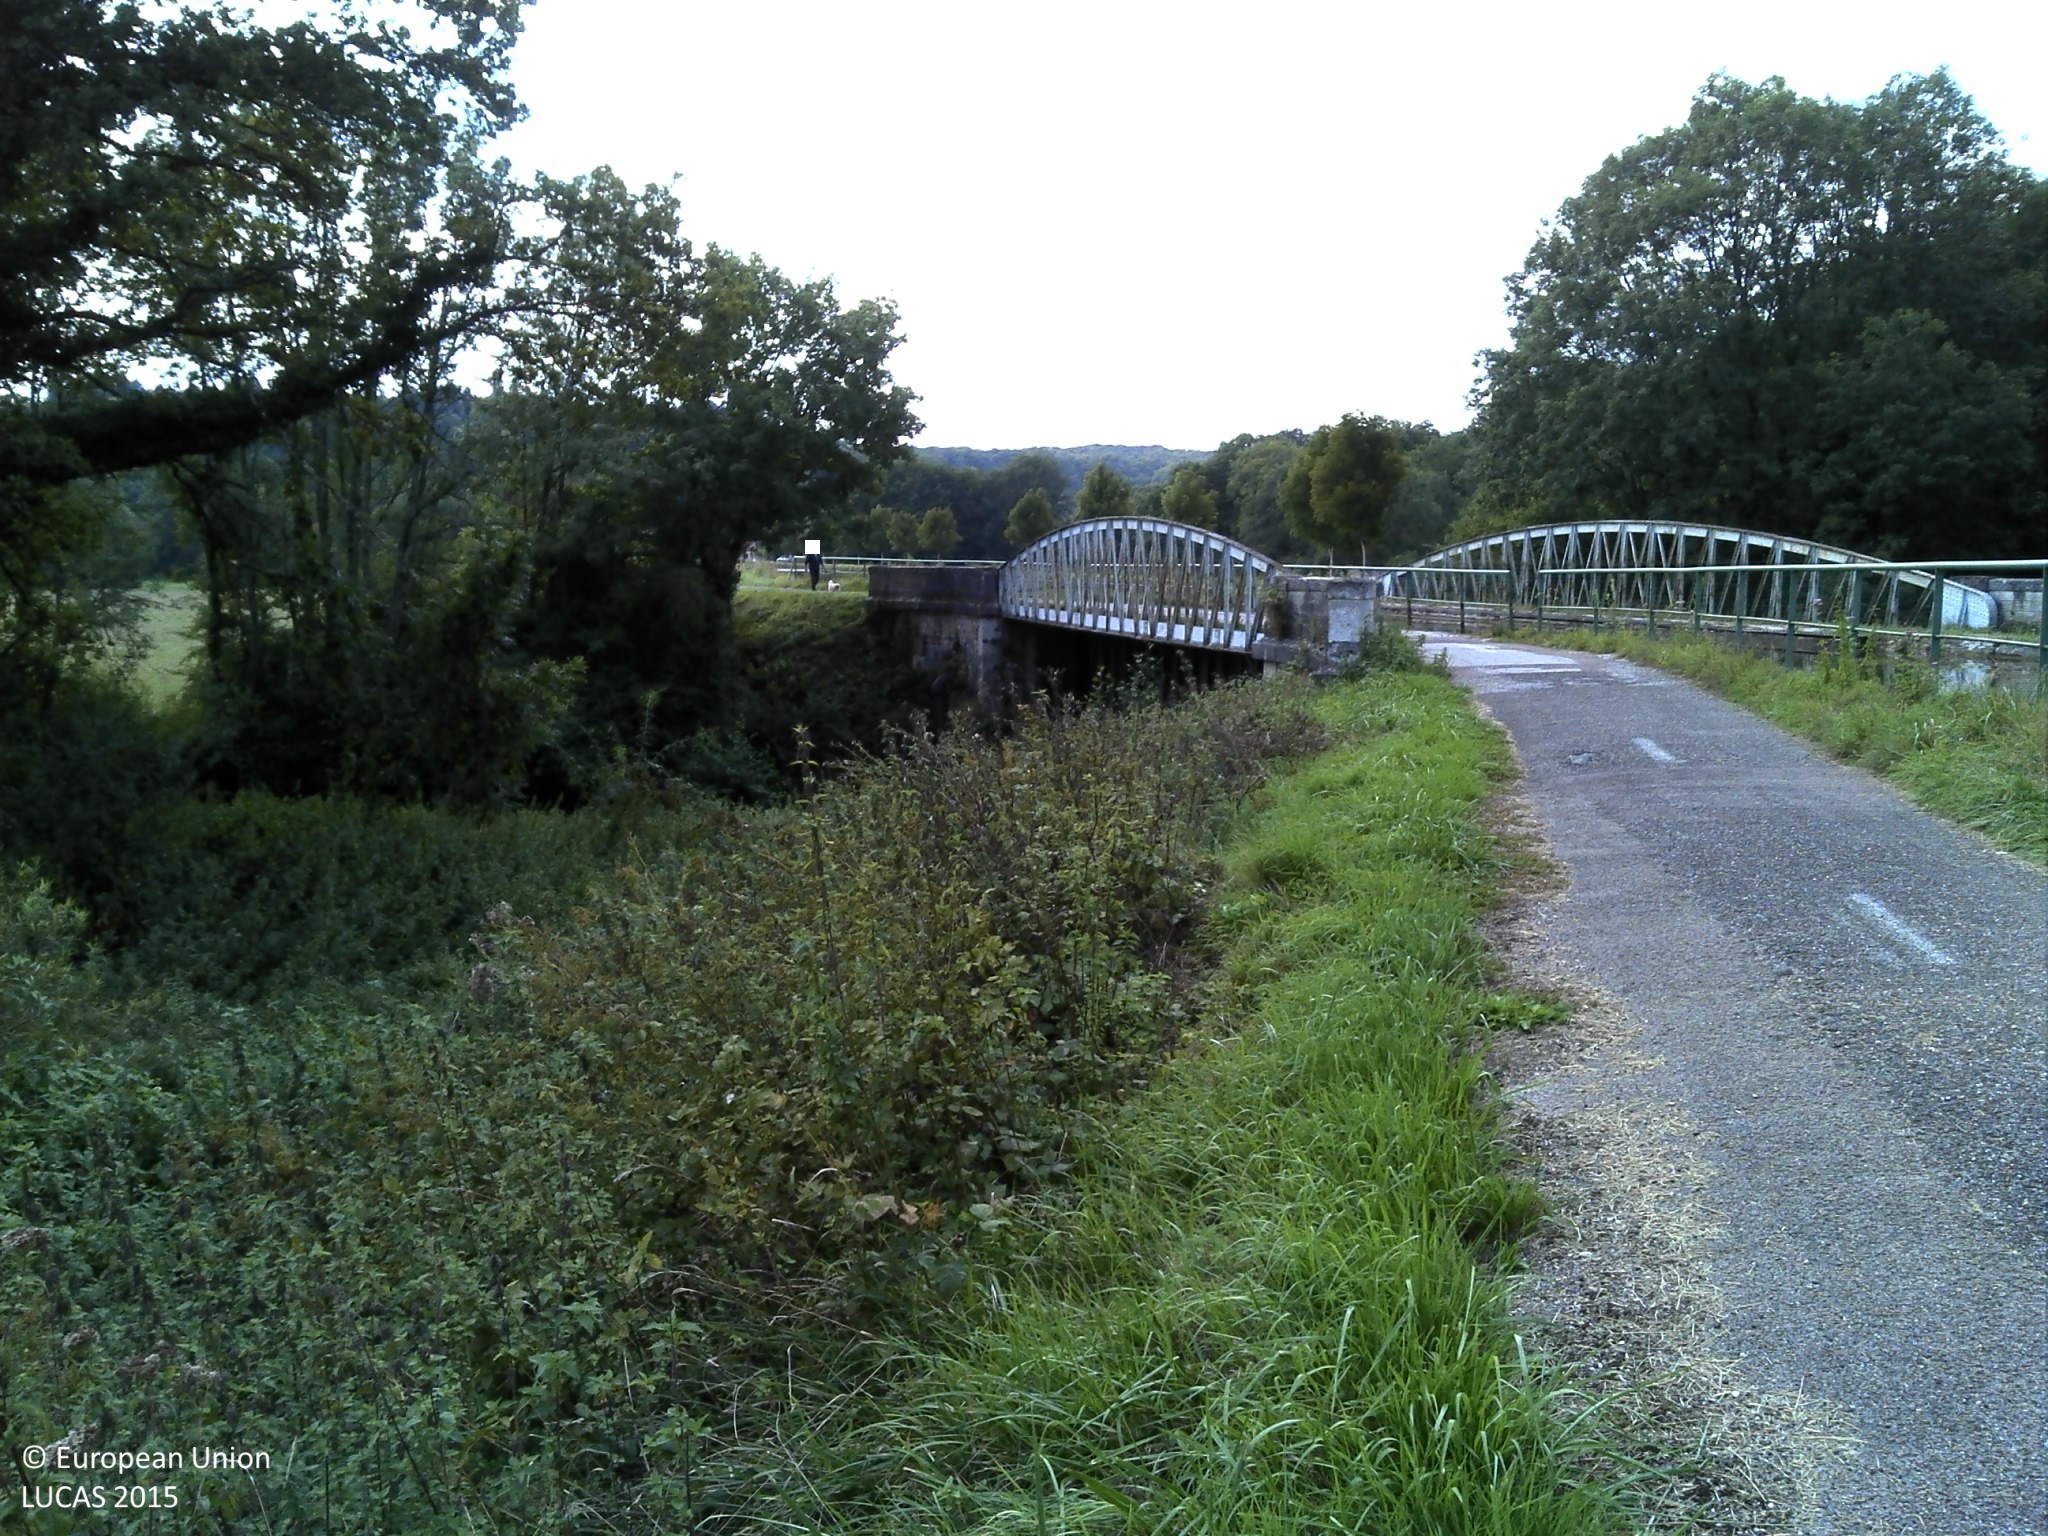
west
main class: Woodland
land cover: Broadleaved woodland
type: floodplain forest
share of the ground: 50 - 75 %
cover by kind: broadleaved forest trees 55 %, herbaceous plants 35 %, shrubs 10 %
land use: Semi-natural and natural areas not in use
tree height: > 5 m
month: September
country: FR
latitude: 48.0474
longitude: 5.2104
